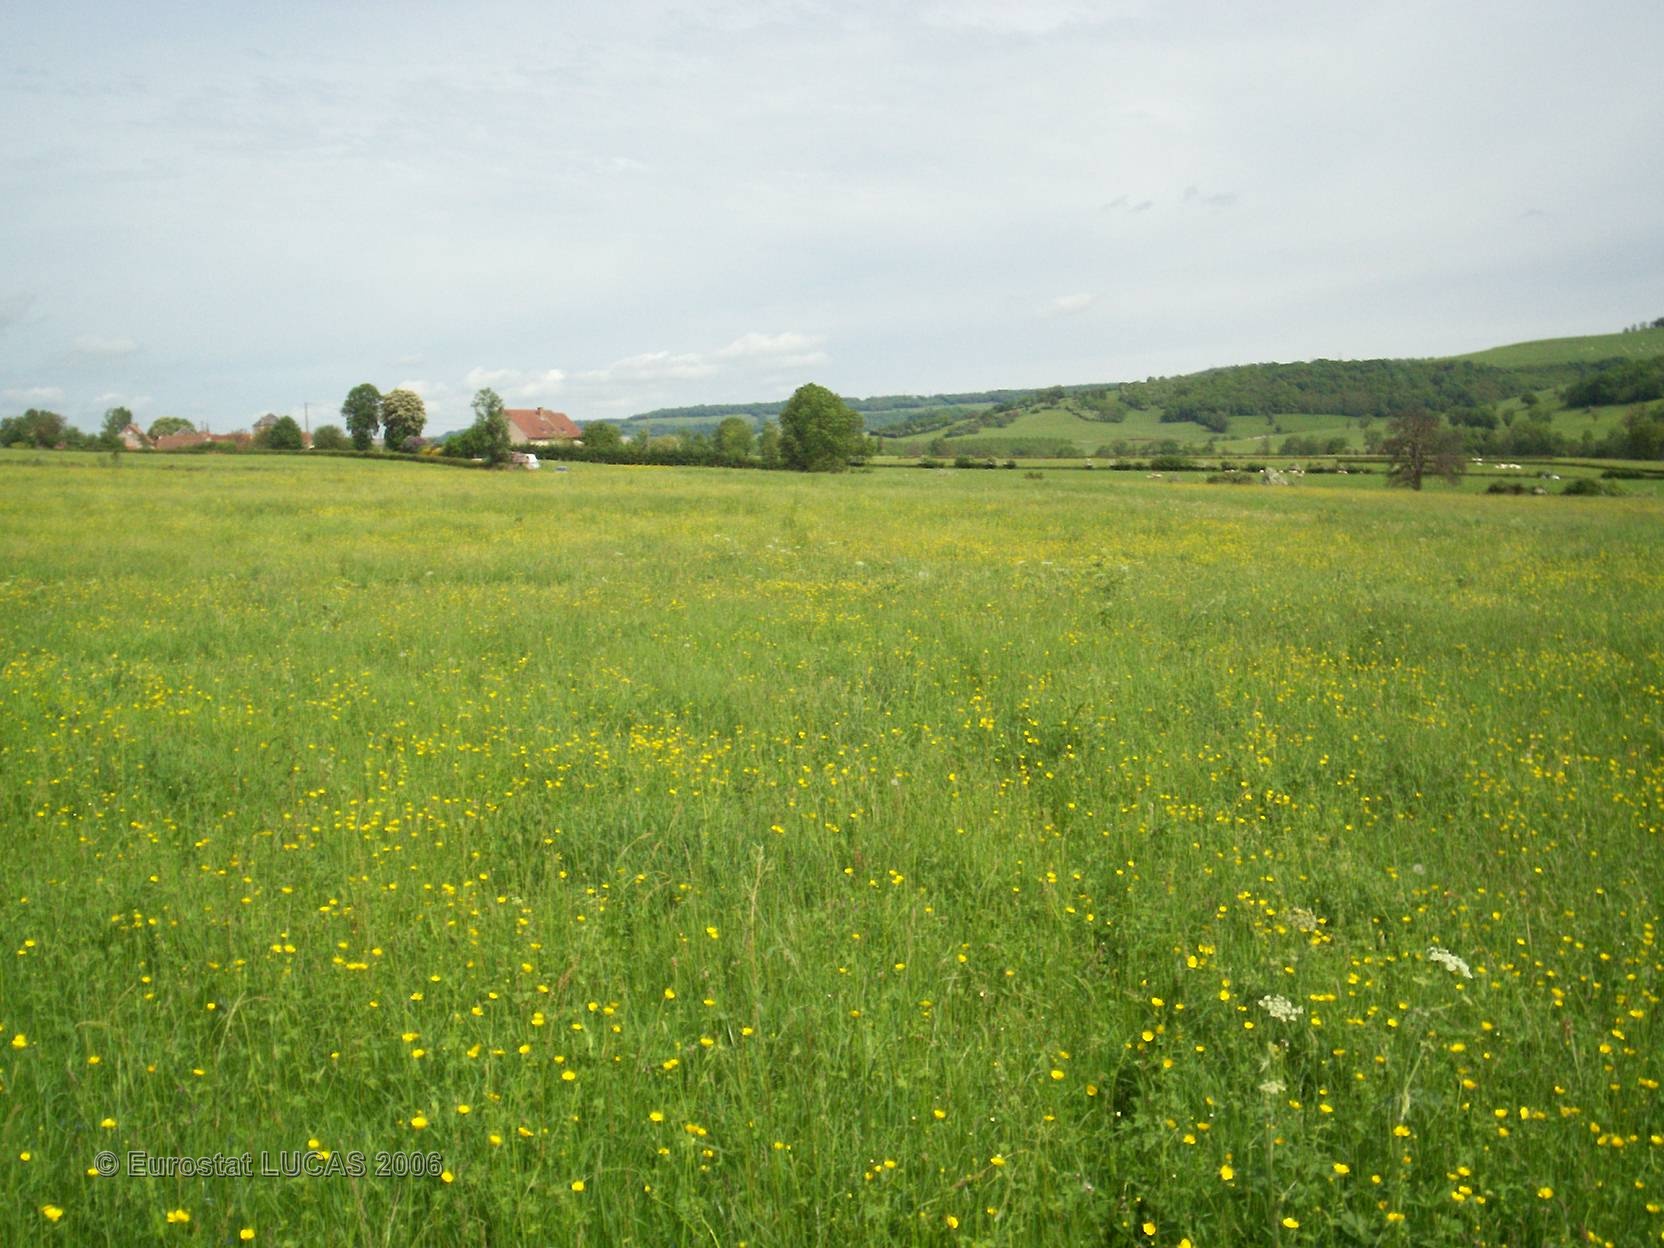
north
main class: Grassland
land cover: Grassland without tree/shrub cover
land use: Agriculture (excluding fallow land and kitchen gardens)
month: May
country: FR
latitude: 47.3676
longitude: 4.5570
